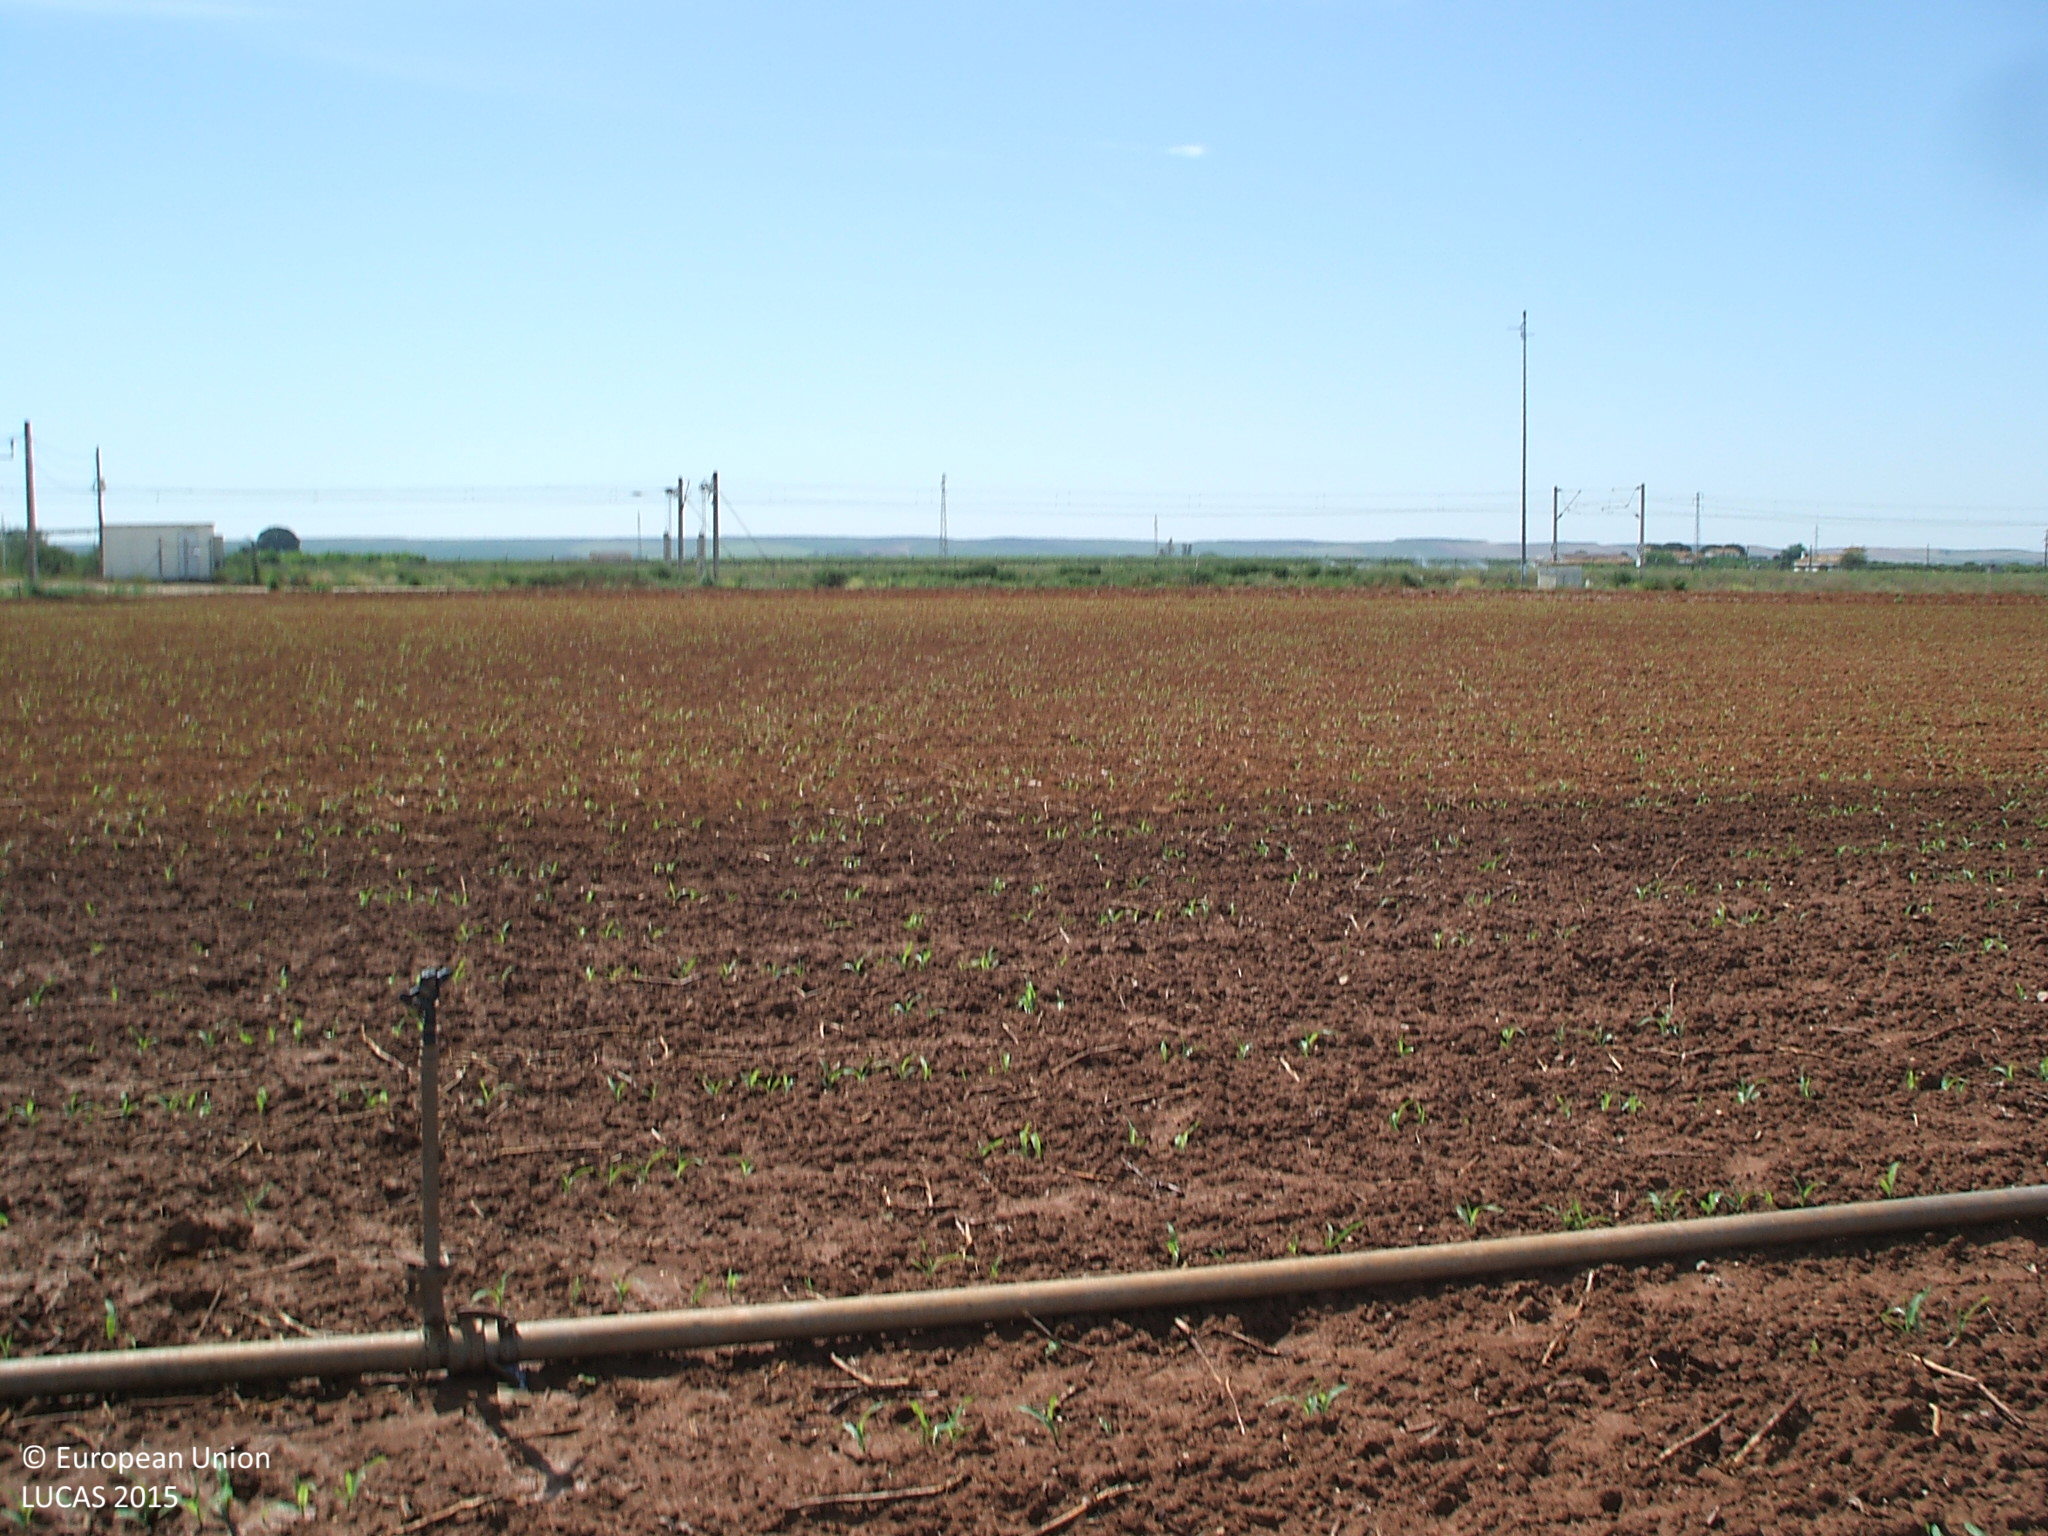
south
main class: Artificial land
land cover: Other artificial areas
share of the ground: < 10 %
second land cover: Maize
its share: < 10 %
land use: Electricity, gas and thermal power distribution
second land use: Agriculture (excluding fallow land and kitchen gardens)
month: April
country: ES
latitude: 37.6913
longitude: -5.4552
